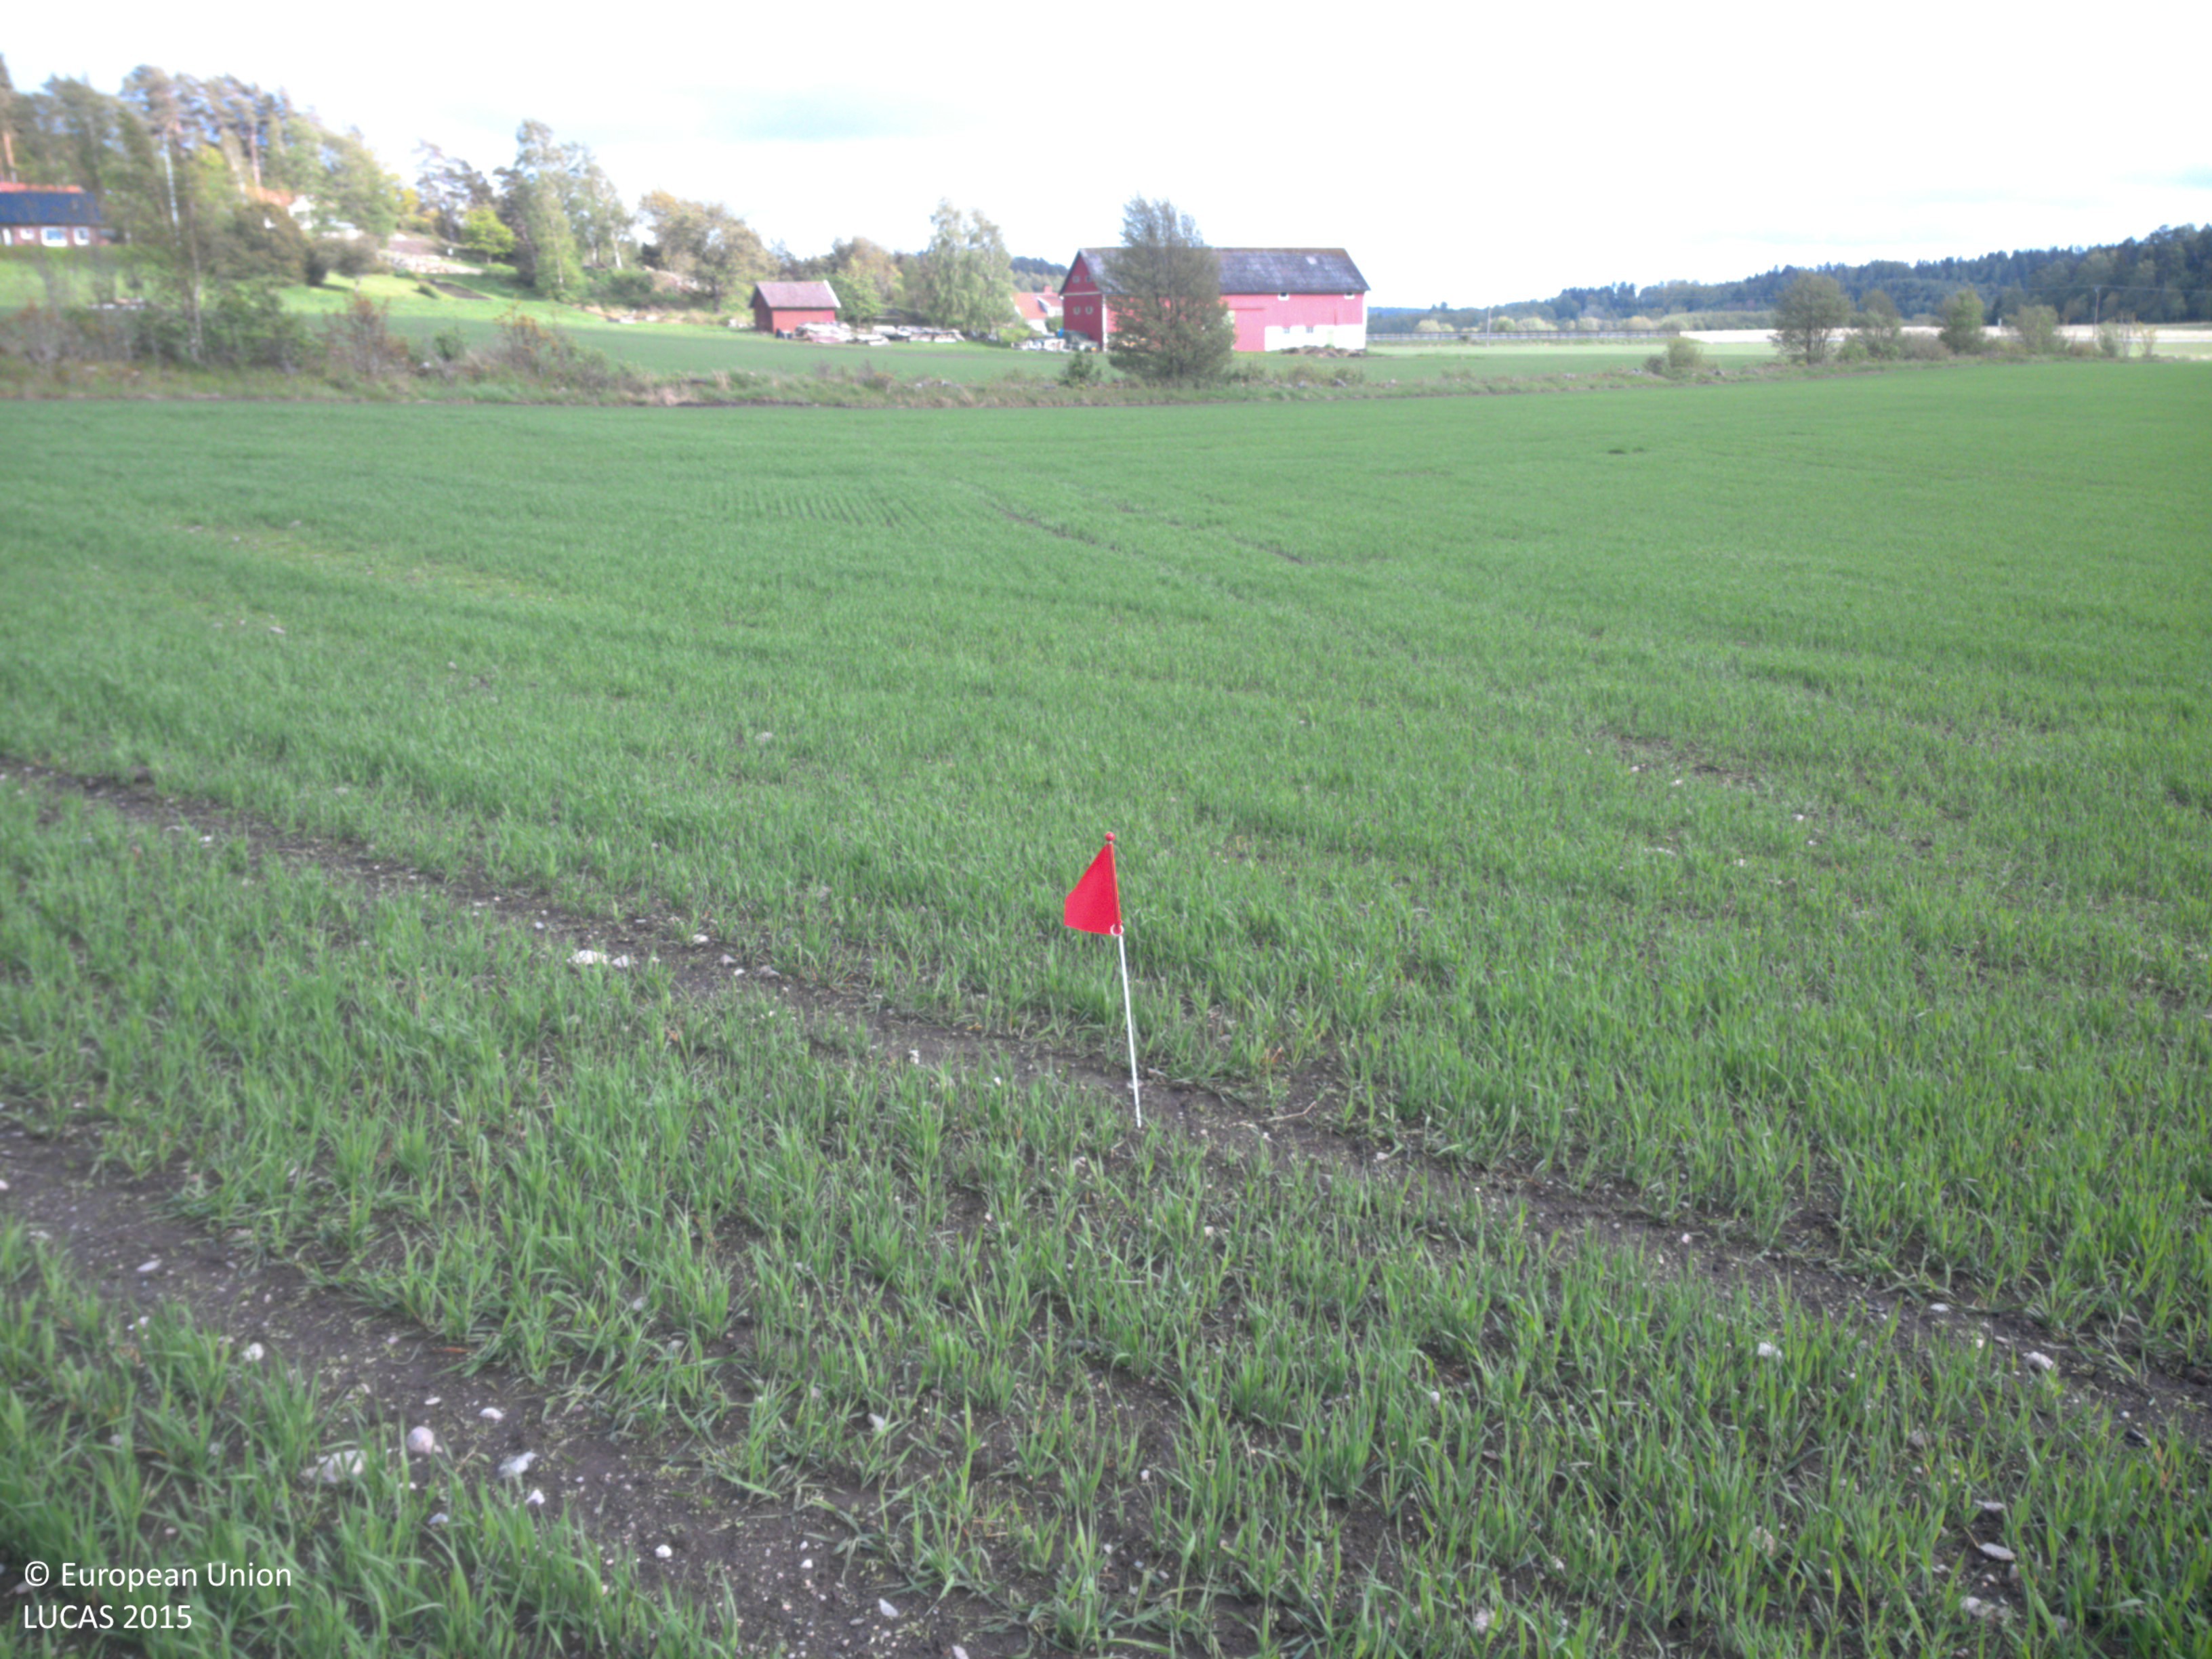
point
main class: Cropland
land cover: Common wheat
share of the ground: 50 - 75 %
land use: Agriculture (excluding fallow land and kitchen gardens)
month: May
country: SE
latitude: 58.3515
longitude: 11.7905
